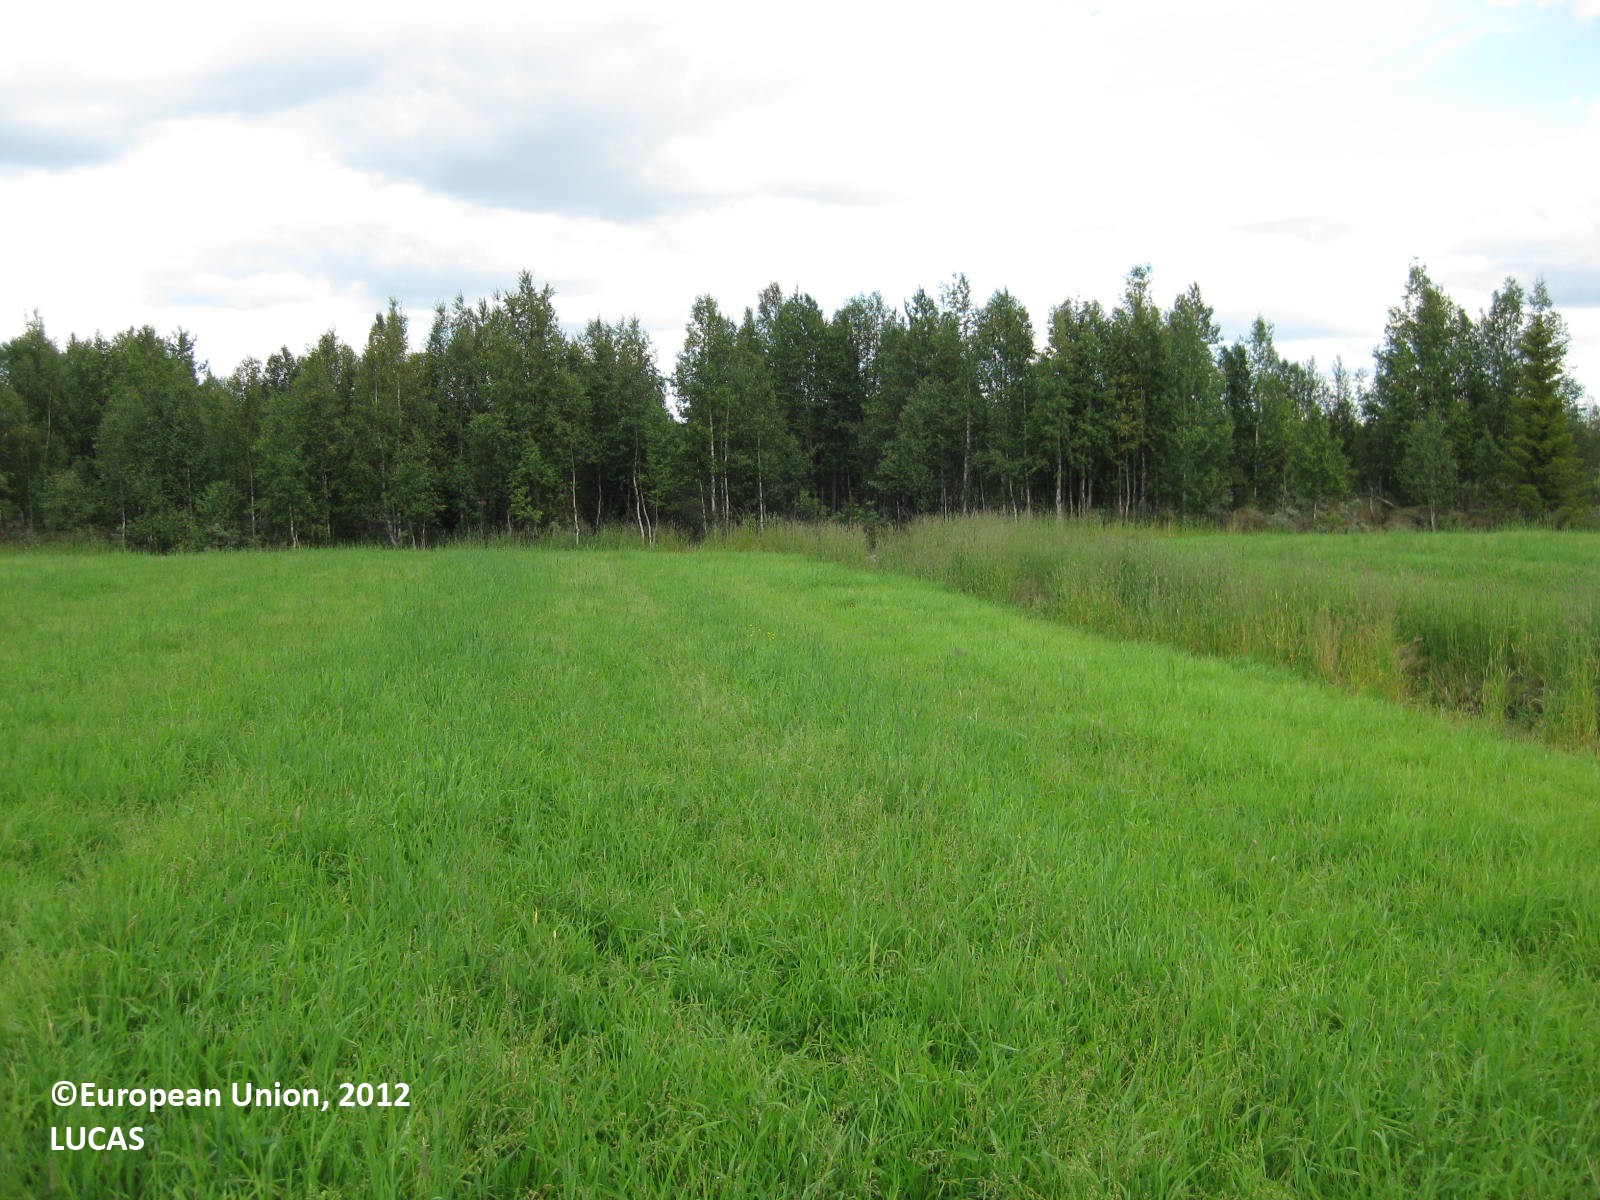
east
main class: Cropland
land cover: Temporary grasslands
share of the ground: > 75 %
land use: Agriculture (excluding fallow land and kitchen gardens)
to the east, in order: Temporary grasslands; Ditches and canals; Broadleaved woodland; Pine dominated mixed woodland; Spruce dominated mixed woodland; Broadleaved woodland; Ditches and canals; Grass margins; Tracks; Grass margins; Ditches and canals; Abandoned hedges; Ditches and canals; Broadleaved woodland
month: August
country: FI
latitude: 66.4359
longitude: 28.5061
